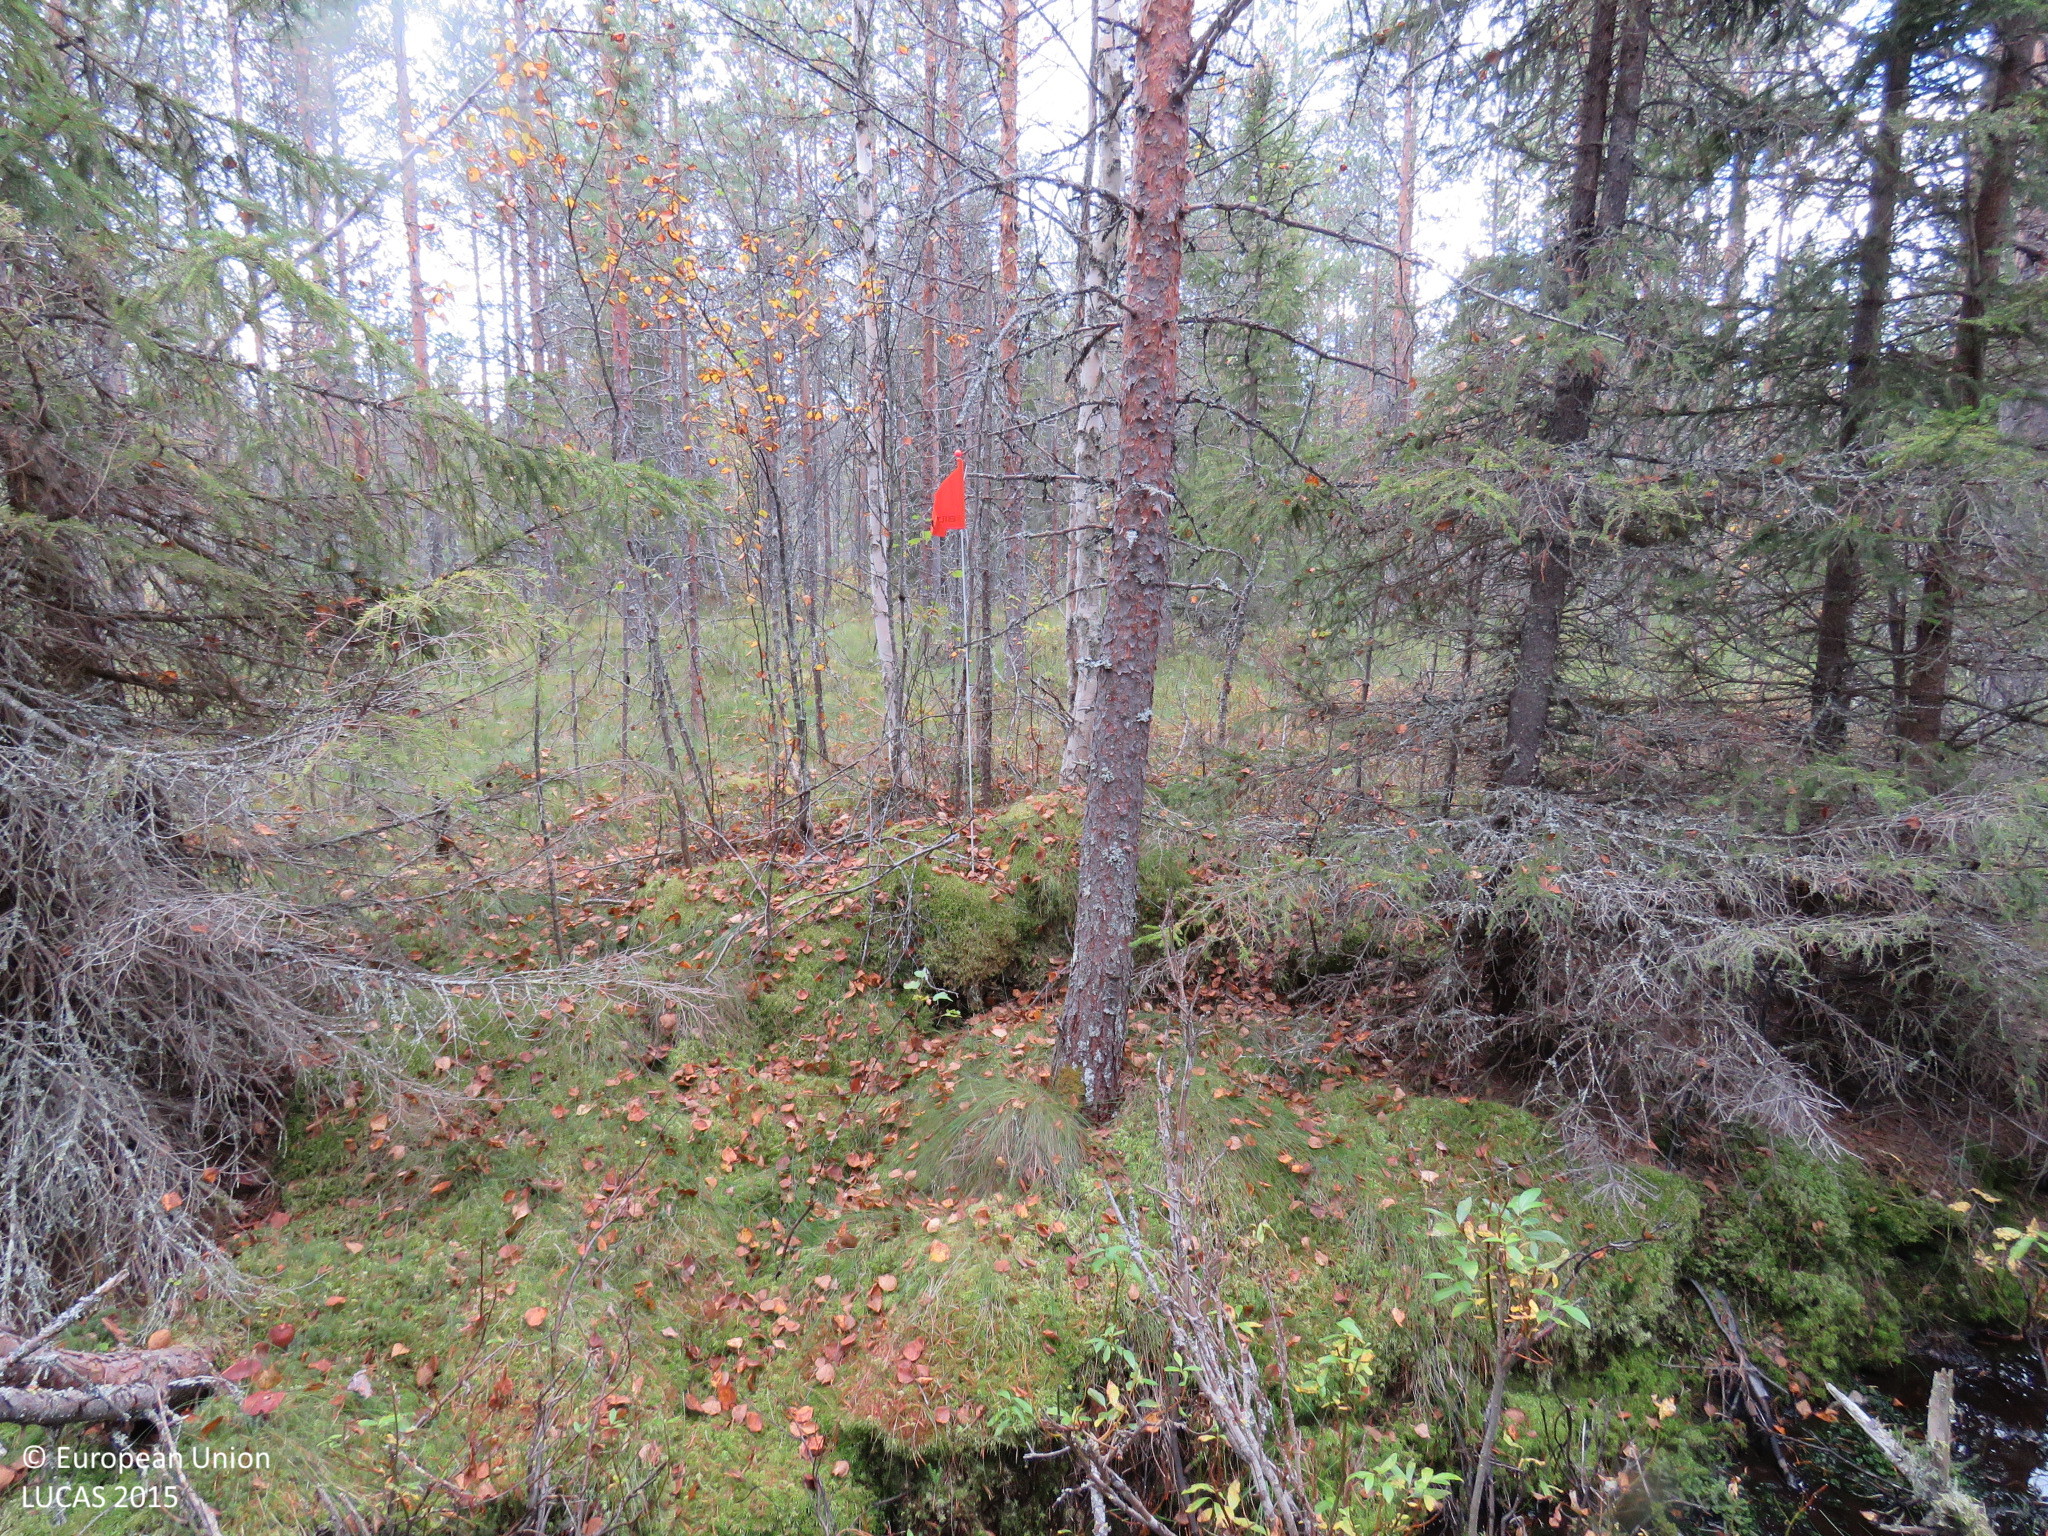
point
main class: Woodland
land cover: Other coniferous woodland
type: mire and swamp forests
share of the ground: > 75 %
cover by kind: coniferous forest trees 60 %, broadleaved forest trees 15 %, shrubs 10 %, herbaceous plants 10 %, lichens and mosses 5 %
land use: Forestry
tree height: > 5 m
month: September
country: FI
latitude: 64.9223
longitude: 26.9748
